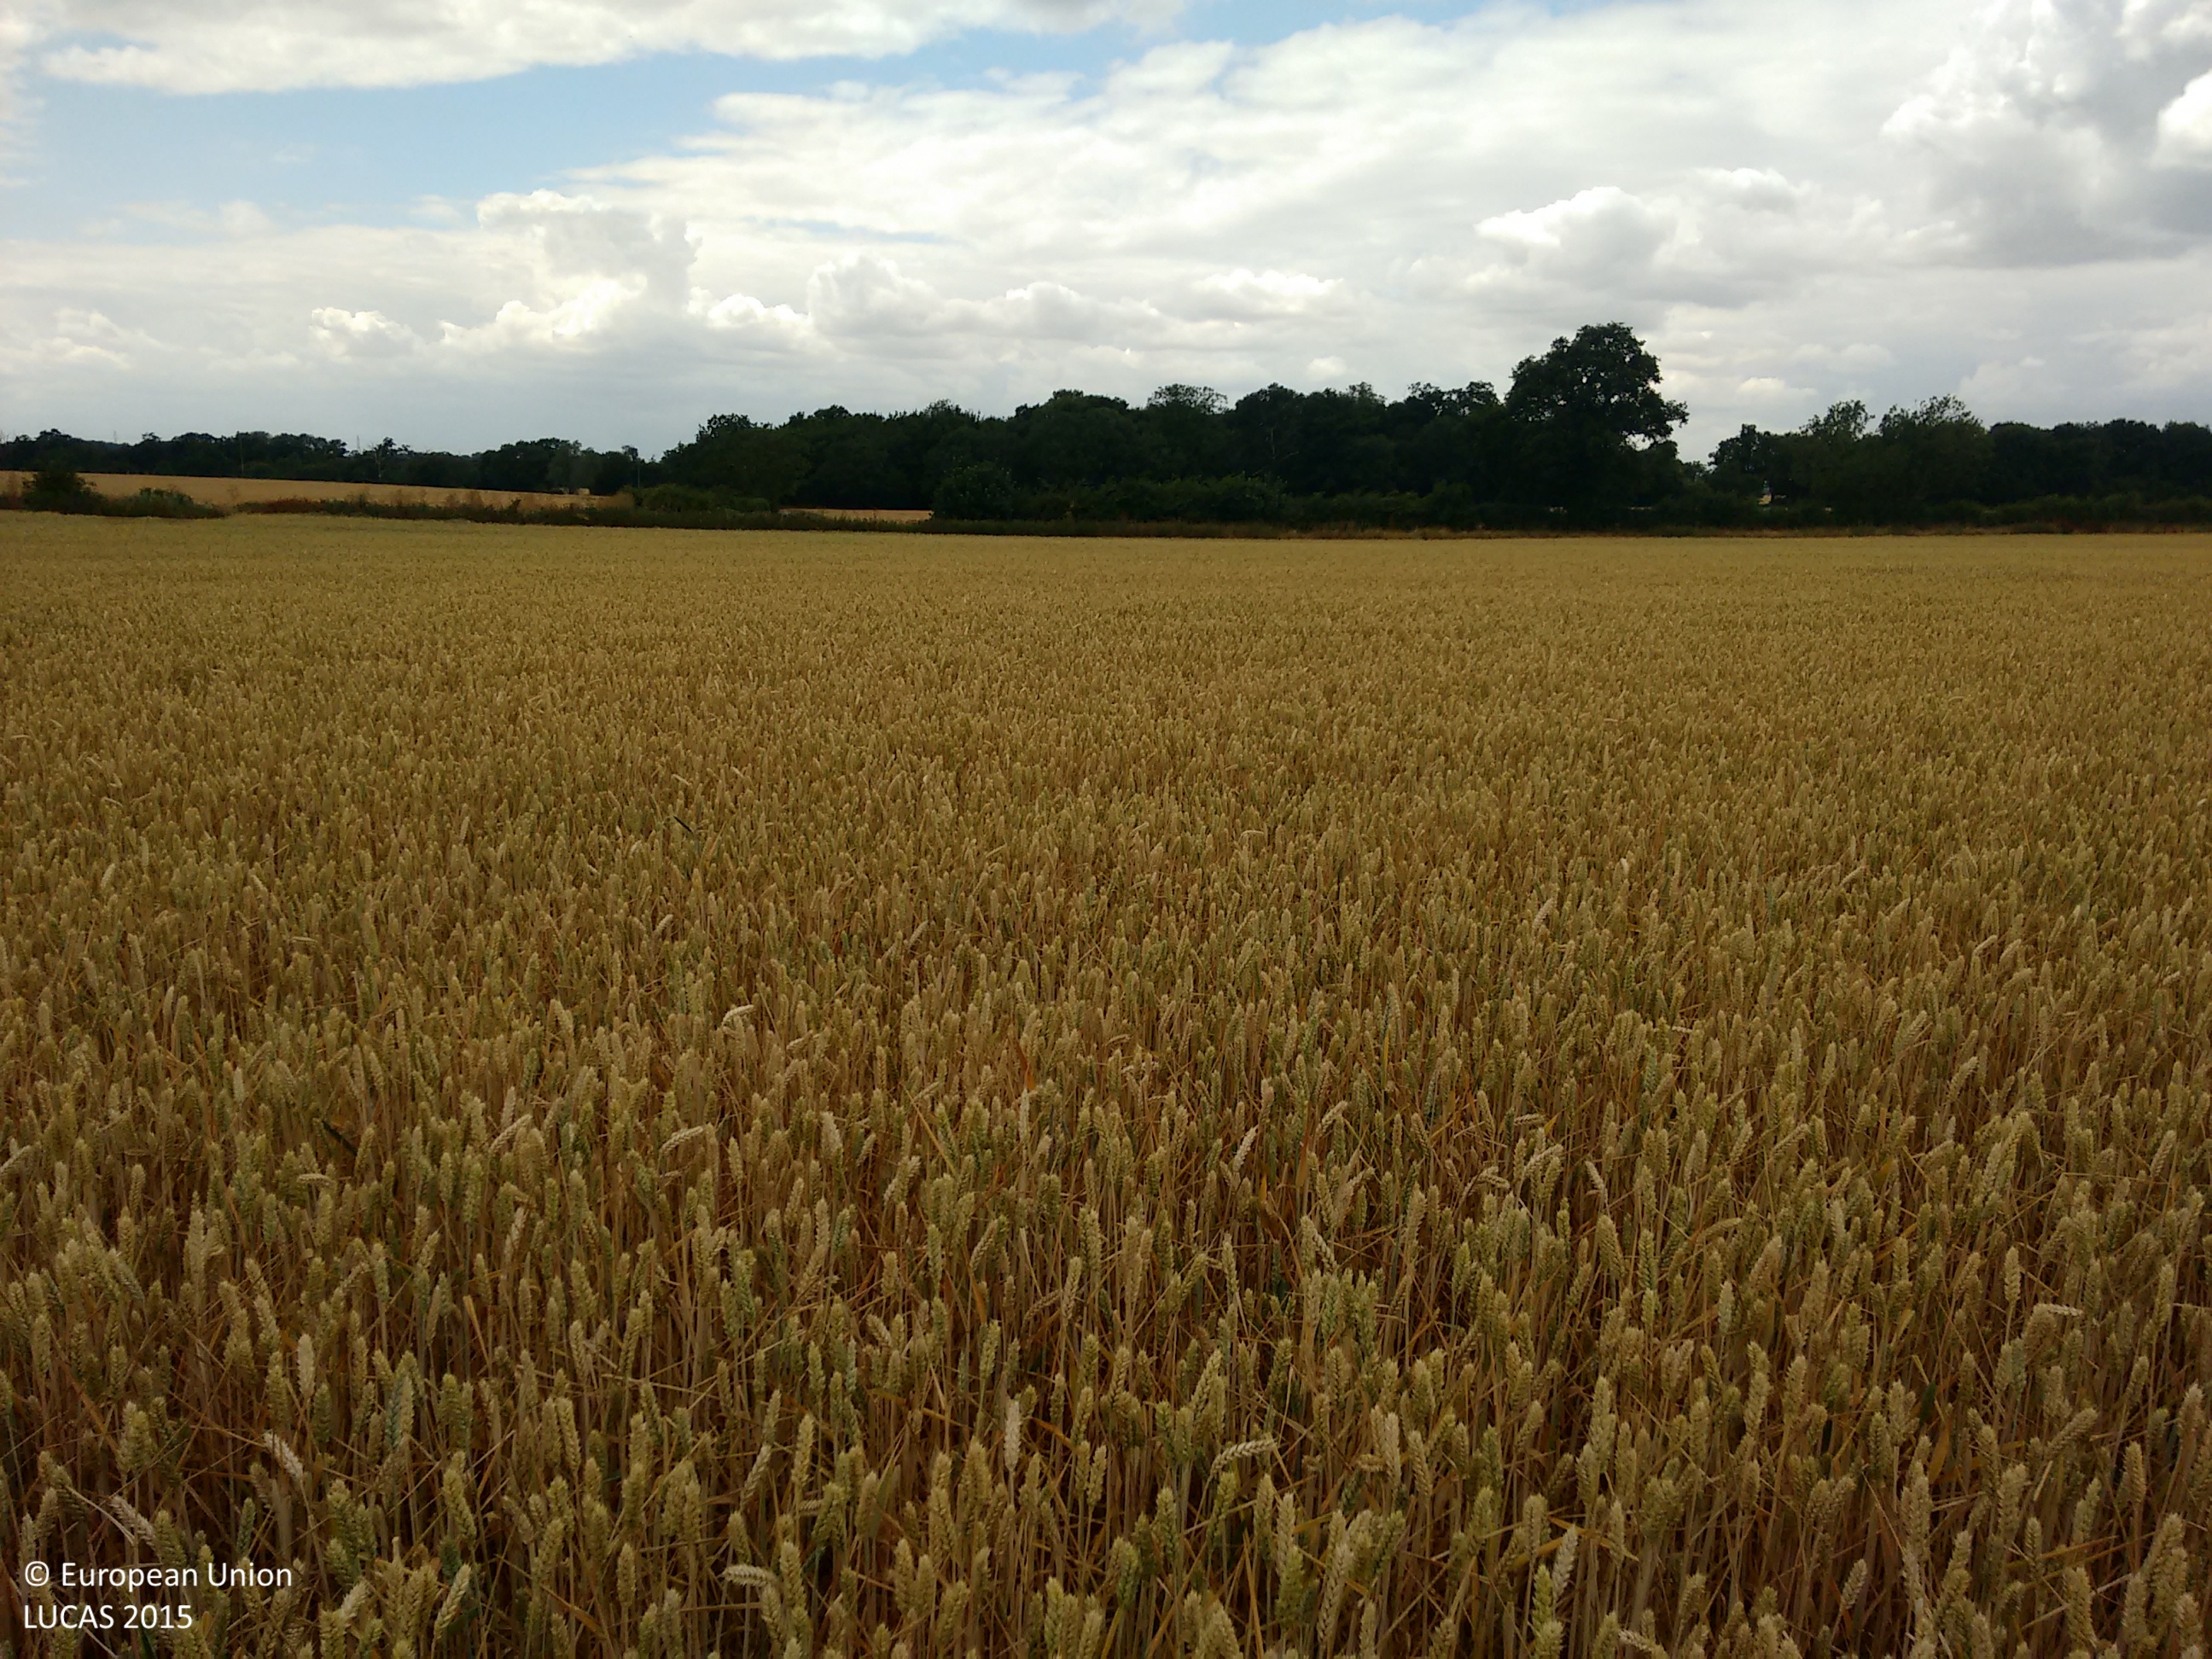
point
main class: Cropland
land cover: Common wheat
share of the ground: > 75 %
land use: Agriculture (excluding fallow land and kitchen gardens)
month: July
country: GB
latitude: 51.8038
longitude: 0.5900
